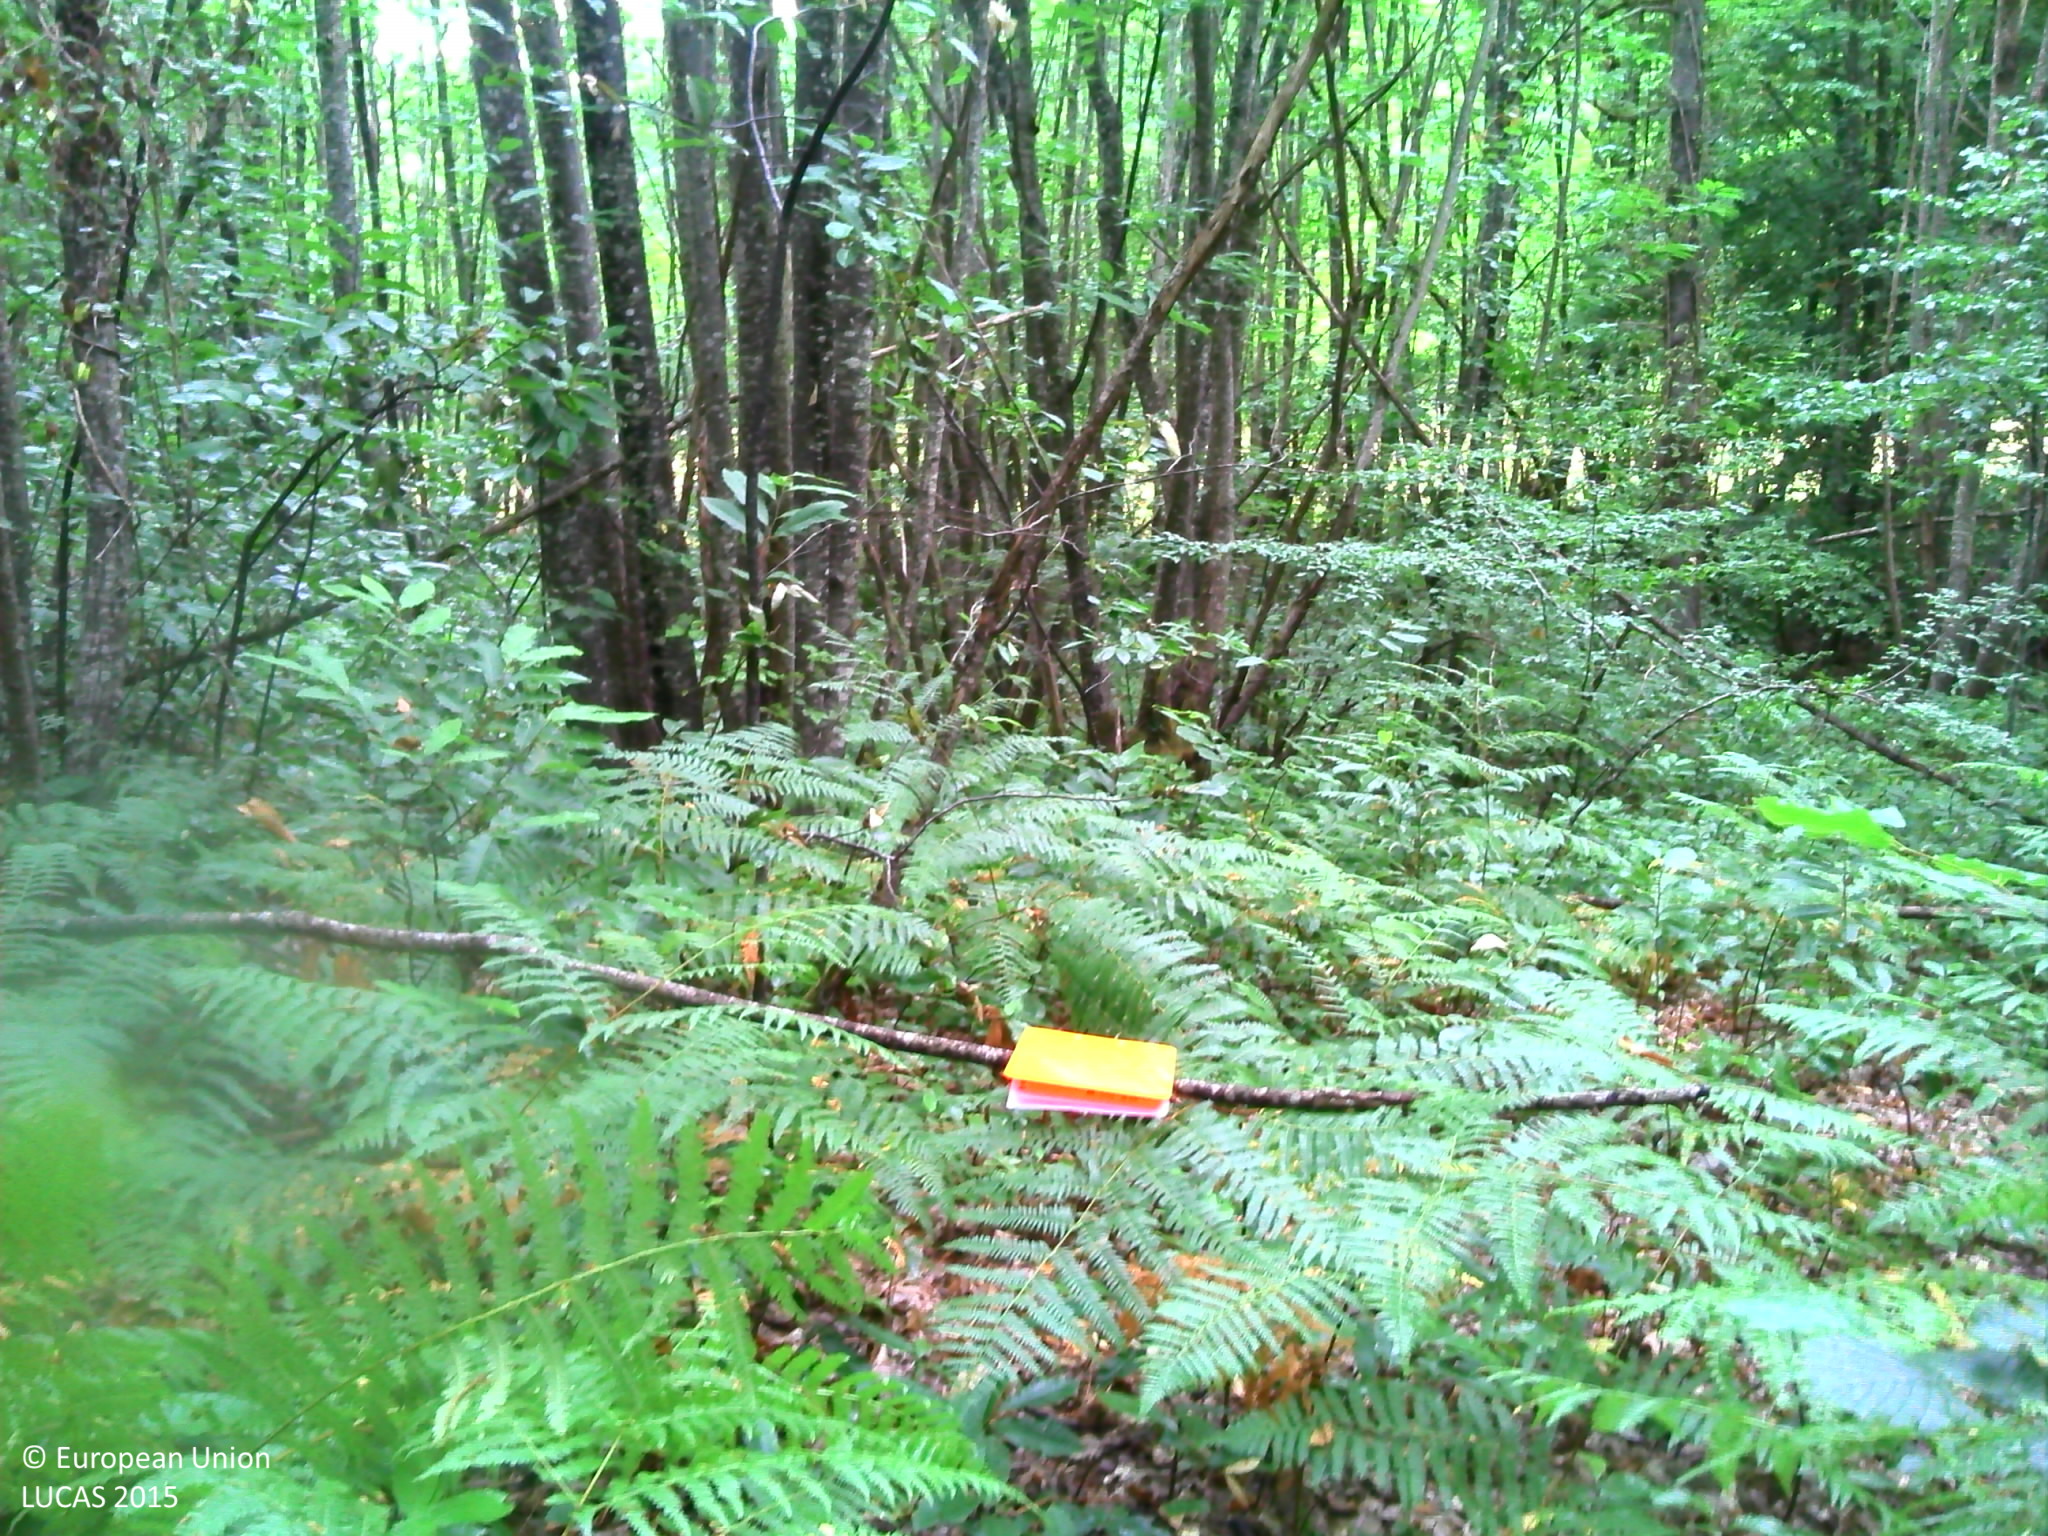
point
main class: Woodland
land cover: Broadleaved woodland
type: thermophilous deciduous forest
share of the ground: > 75 %
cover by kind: broadleaved forest trees 80 %, herbaceous plants 10 %, shrubs 5 %, lichens and mosses 5 %
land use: Forestry
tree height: > 5 m
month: August
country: FR
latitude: 44.6553
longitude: 0.8765
